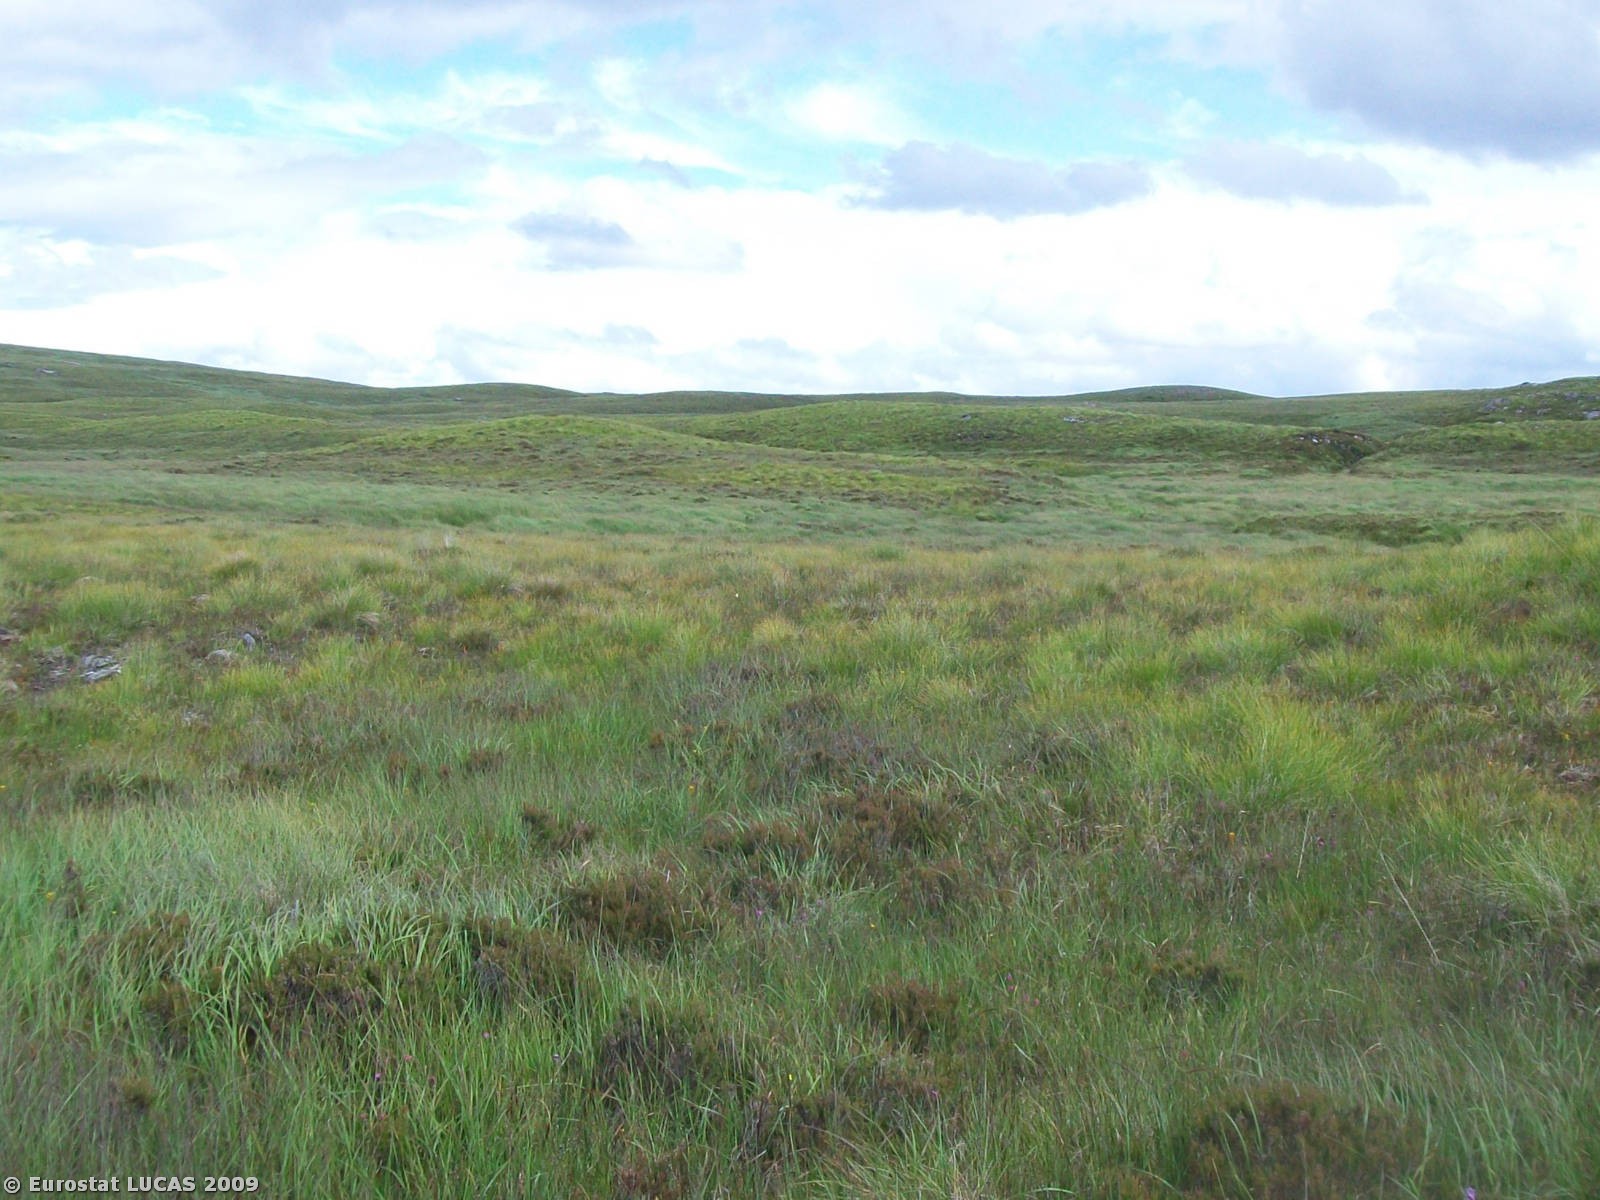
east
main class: Shrubland
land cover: Shrubland without tree cover
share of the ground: > 75 %
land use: Fallow land
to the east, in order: Shrubland without tree cover; Rivers and streams; Shrubland without tree cover; Rivers and streams; Grassland without tree/shrub cover; Shrubland without tree cover; Grassland without tree/shrub cover; Shrubland without tree cover; Grassland without tree/shrub cover; Rivers and streams; Grassland without tree/shrub cover
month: July
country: GB
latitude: 58.3200
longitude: -4.5471
